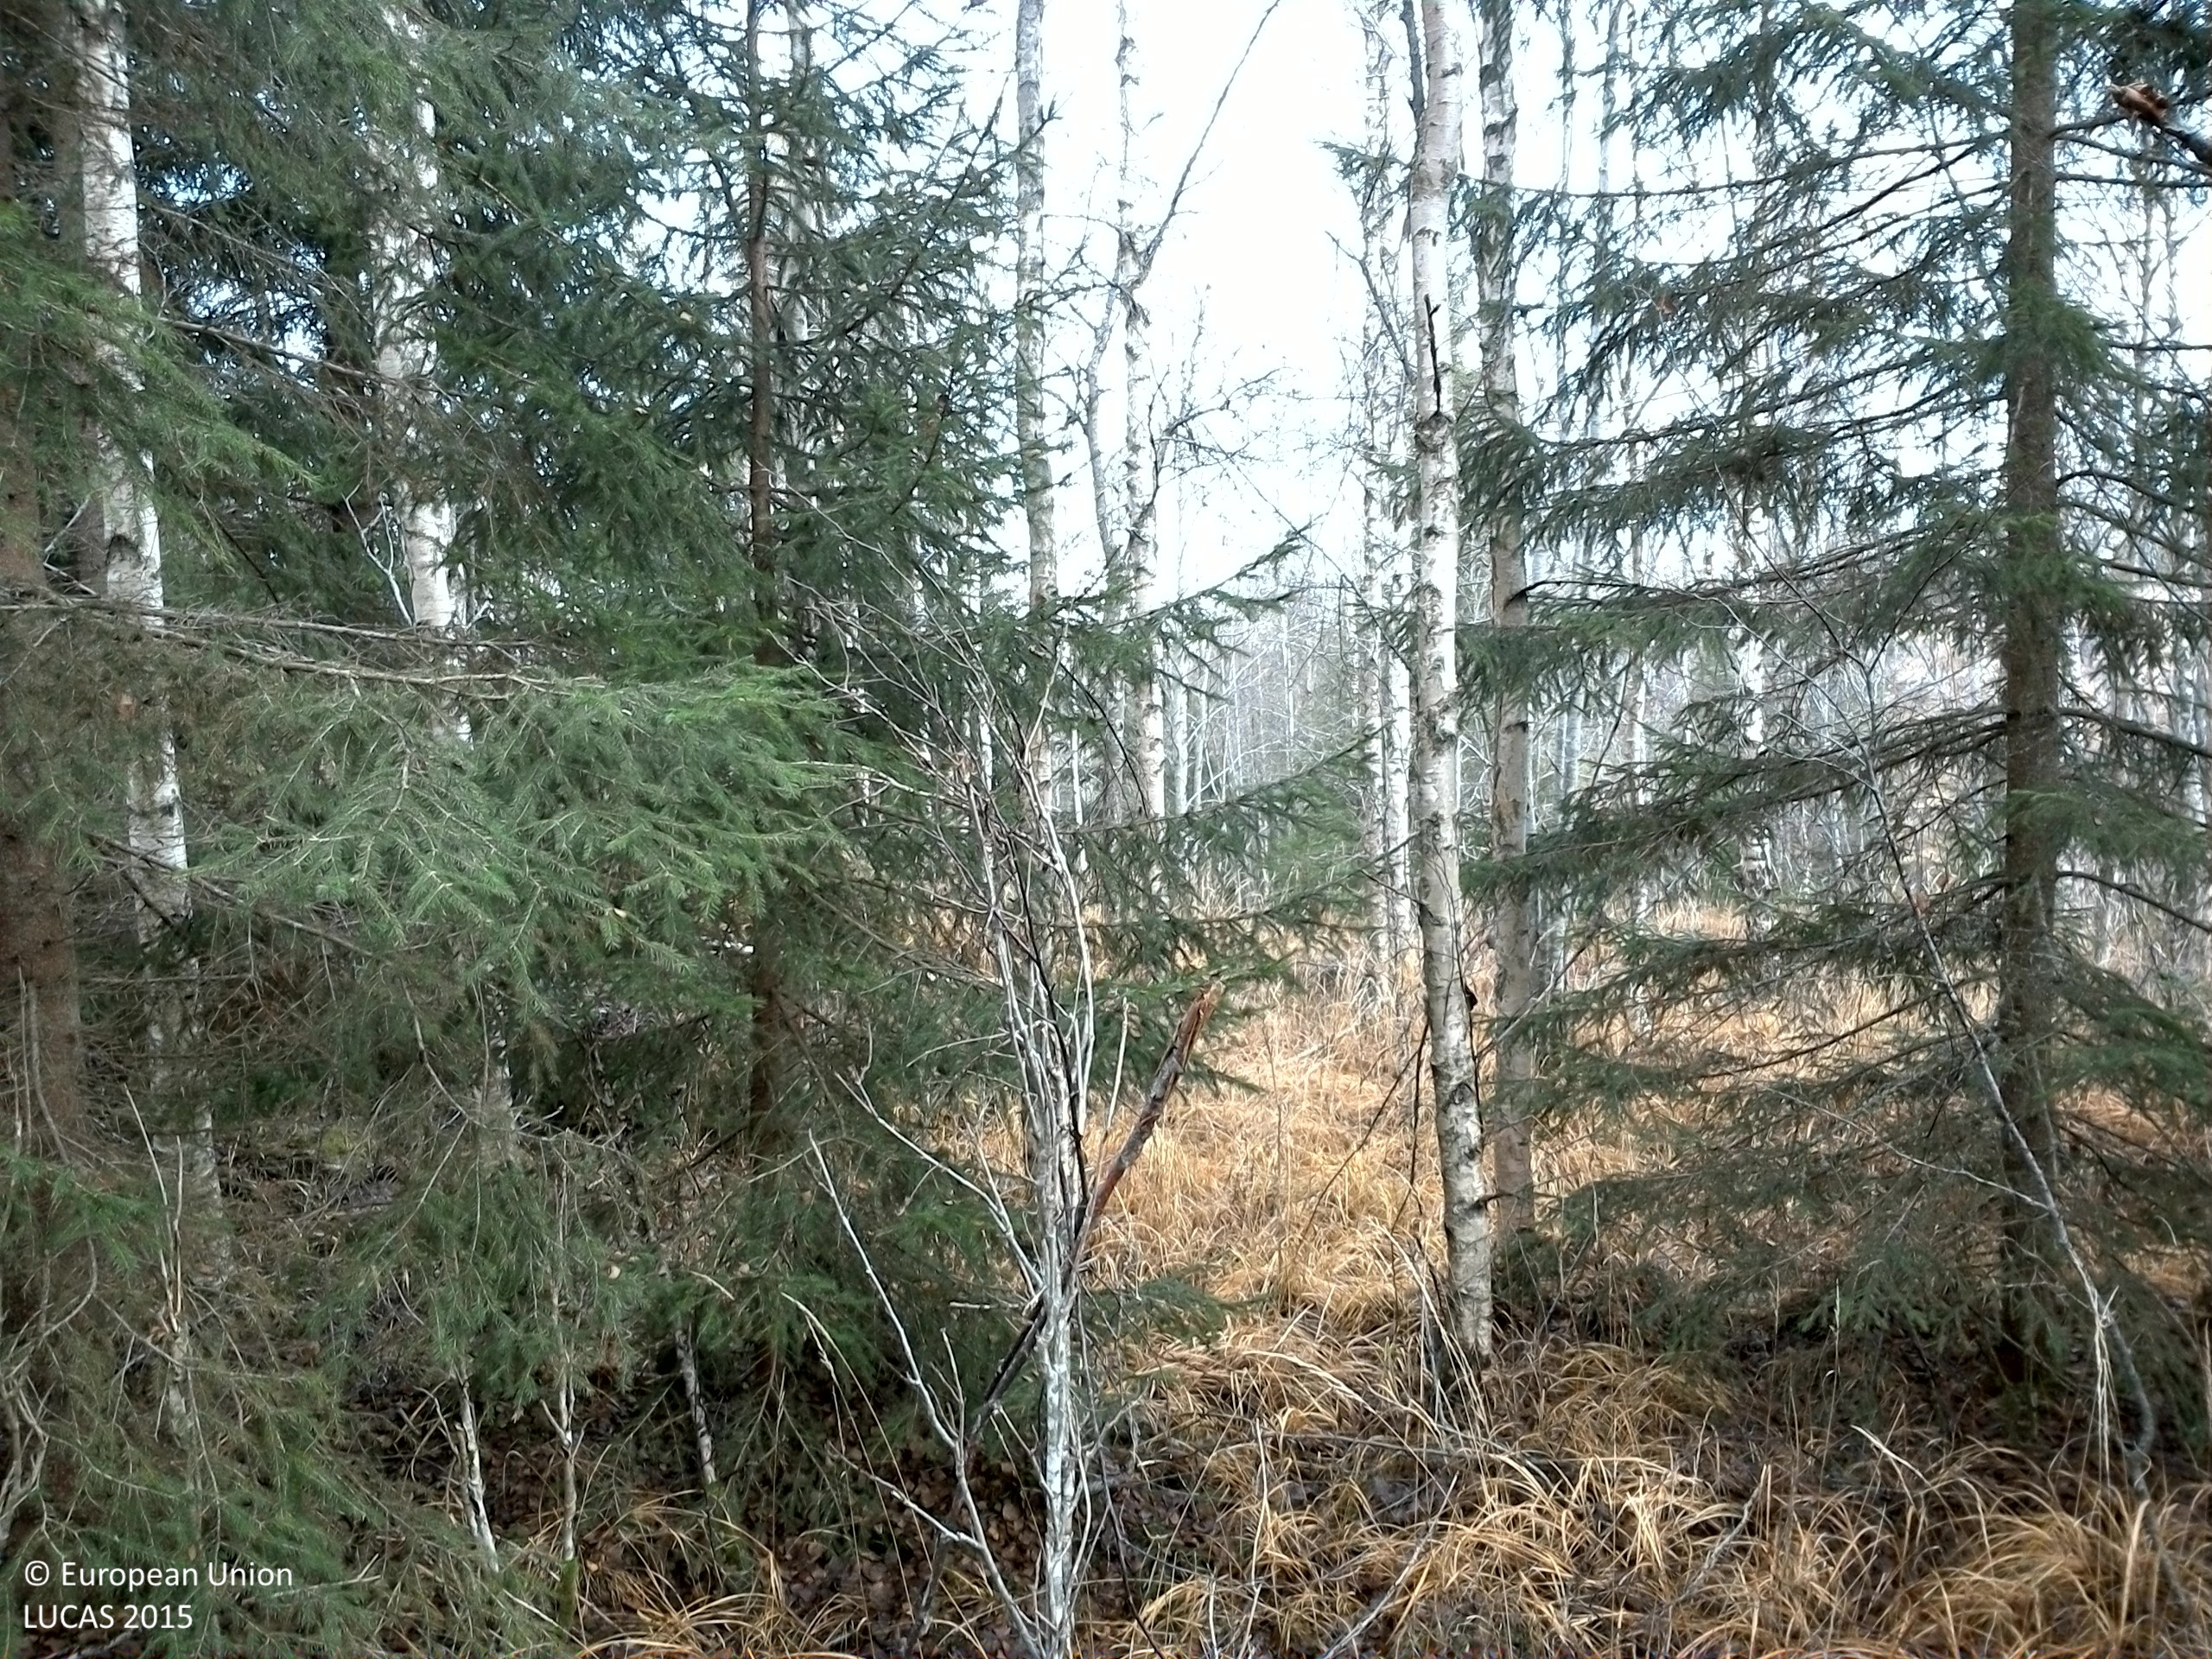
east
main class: Woodland
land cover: Other mixed woodland
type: boreal forest
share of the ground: 50 - 75 %
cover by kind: coniferous forest trees 35 %, broadleaved forest trees 30 %, shrubs 15 %, herbaceous plants 15 %, lichens and mosses 5 %
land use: Forestry
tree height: > 5 m
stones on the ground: 10 - 25 %
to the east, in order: Other mixed woodland; Broadleaved woodland; Other mixed woodland; Rivers and streams; Other mixed woodland; Spruce dominated mixed woodland; Electric lines; Other mixed woodland; Spruce dominated mixed woodland; Broadleaved woodland; Ditches and canals; Spruce dominated mixed woodland
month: November
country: SE
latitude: 60.1495
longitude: 14.9061
